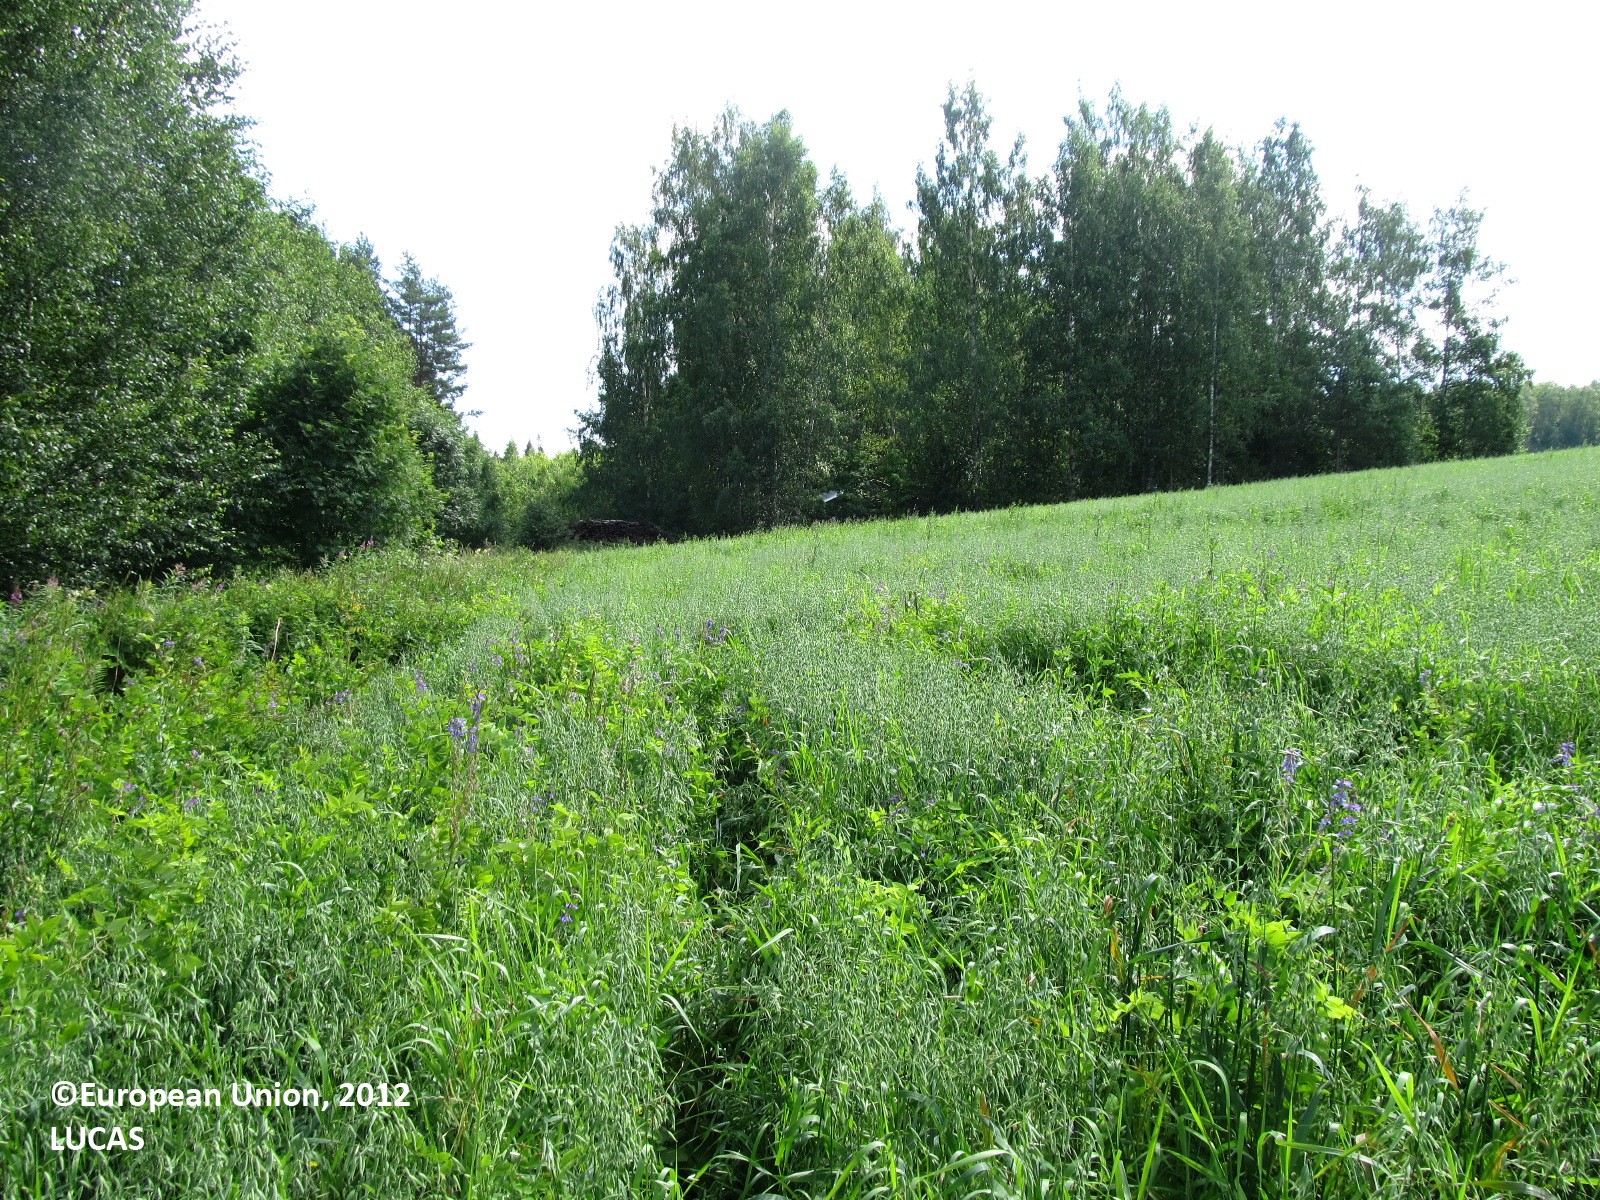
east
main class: Cropland
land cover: Oats
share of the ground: 50 - 75 %
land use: Agriculture (excluding fallow land and kitchen gardens)
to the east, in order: Oats; Ditches and canals; Tracks; Broadleaved woodland
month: July
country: FI
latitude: 61.9734
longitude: 28.6209
